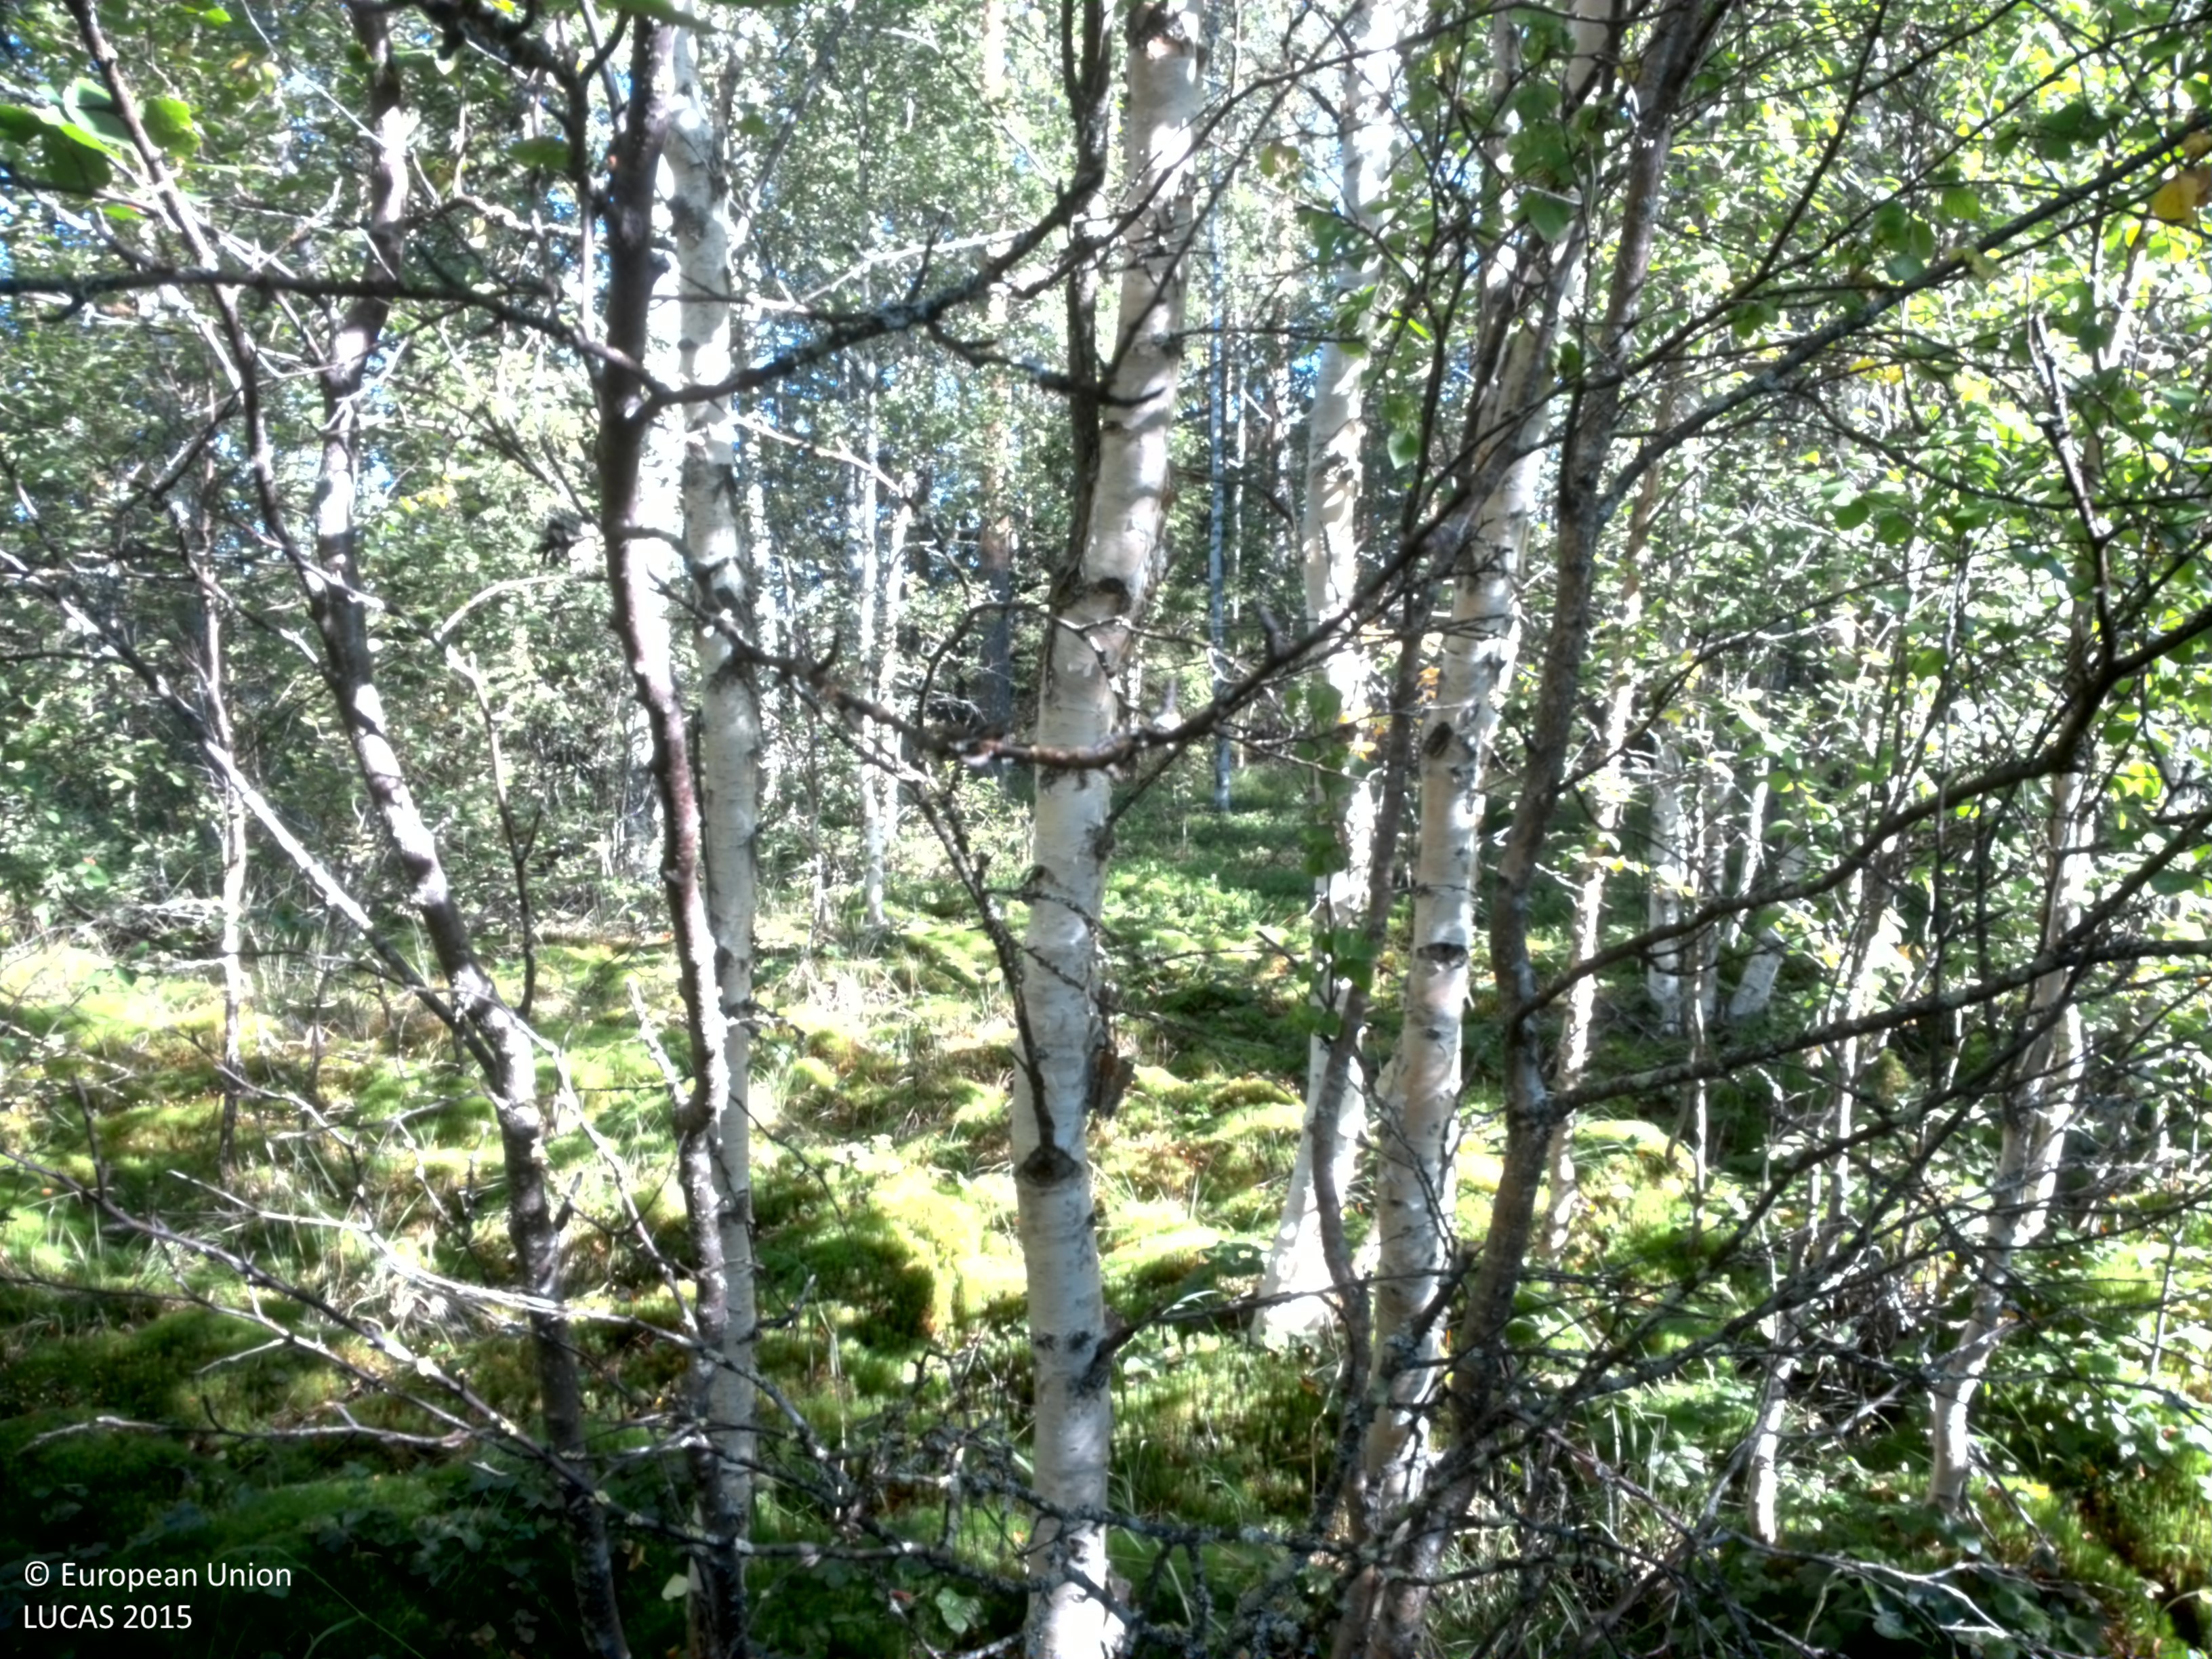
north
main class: Woodland
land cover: Broadleaved woodland
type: boreal forest
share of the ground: 50 - 75 %
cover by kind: broadleaved forest trees 75 %, lichens and mosses 25 %
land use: Forestry
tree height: < 5 m
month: August
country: SE
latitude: 64.2905
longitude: 18.6271
